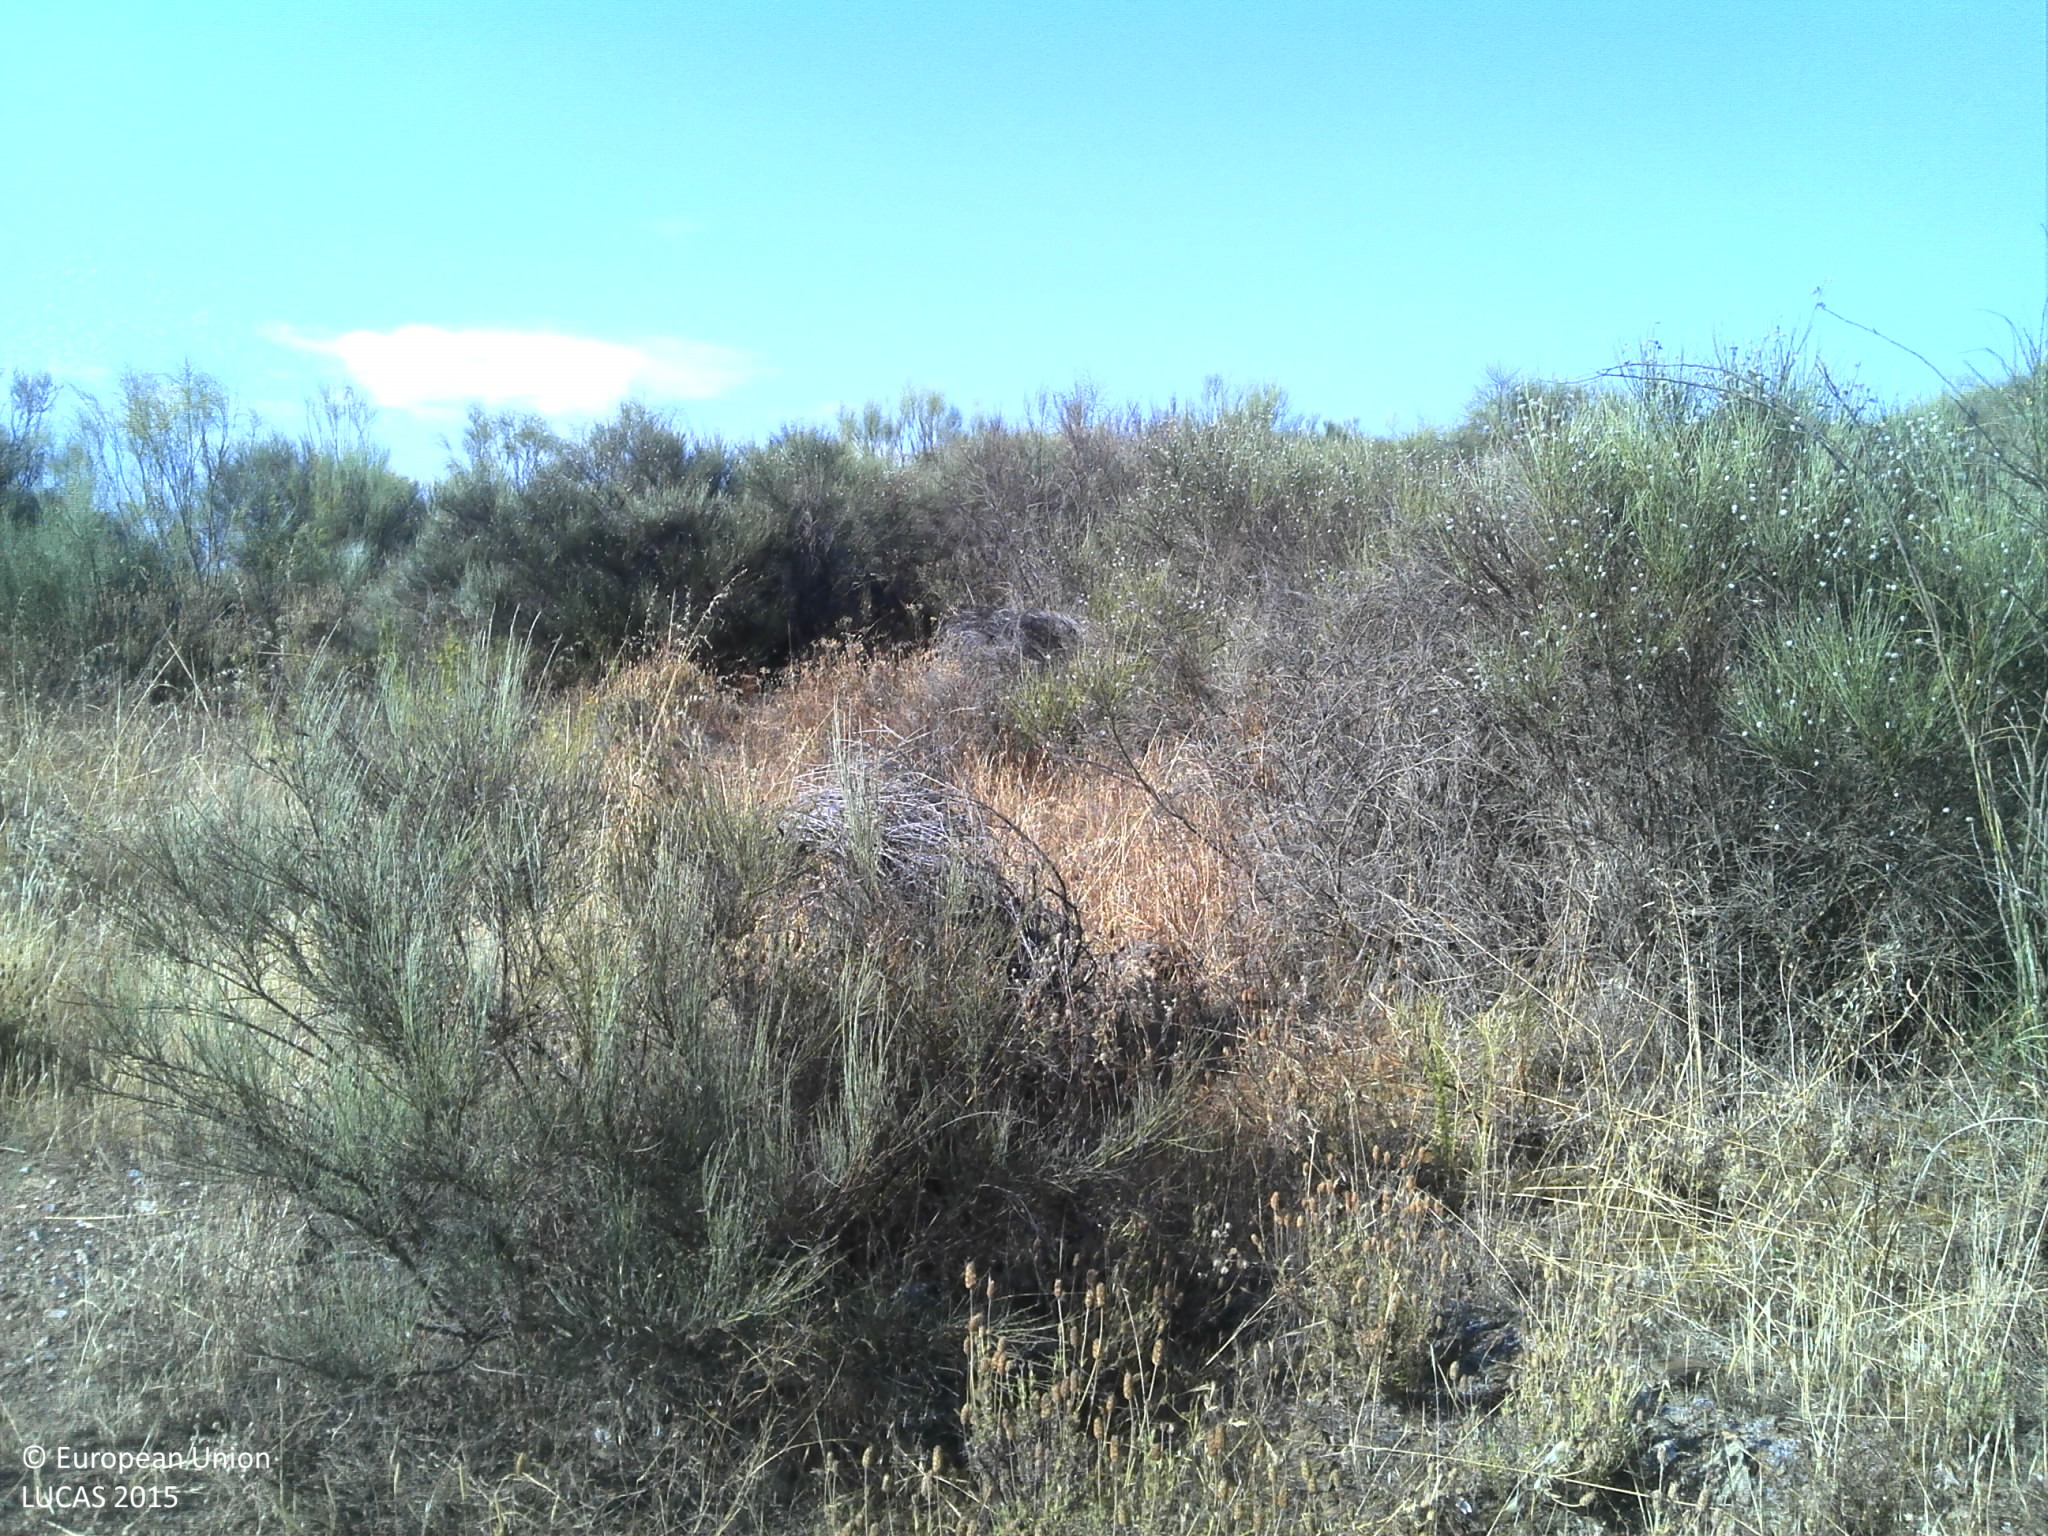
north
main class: Shrubland
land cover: Shrubland without tree cover
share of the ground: 50 - 75 %
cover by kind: shrubs 70 %, herbaceous plants 15 %, unconsolidated bare surface 10 %
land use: Abandoned areas
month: June
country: PT
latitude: 39.8021
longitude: -7.0111
